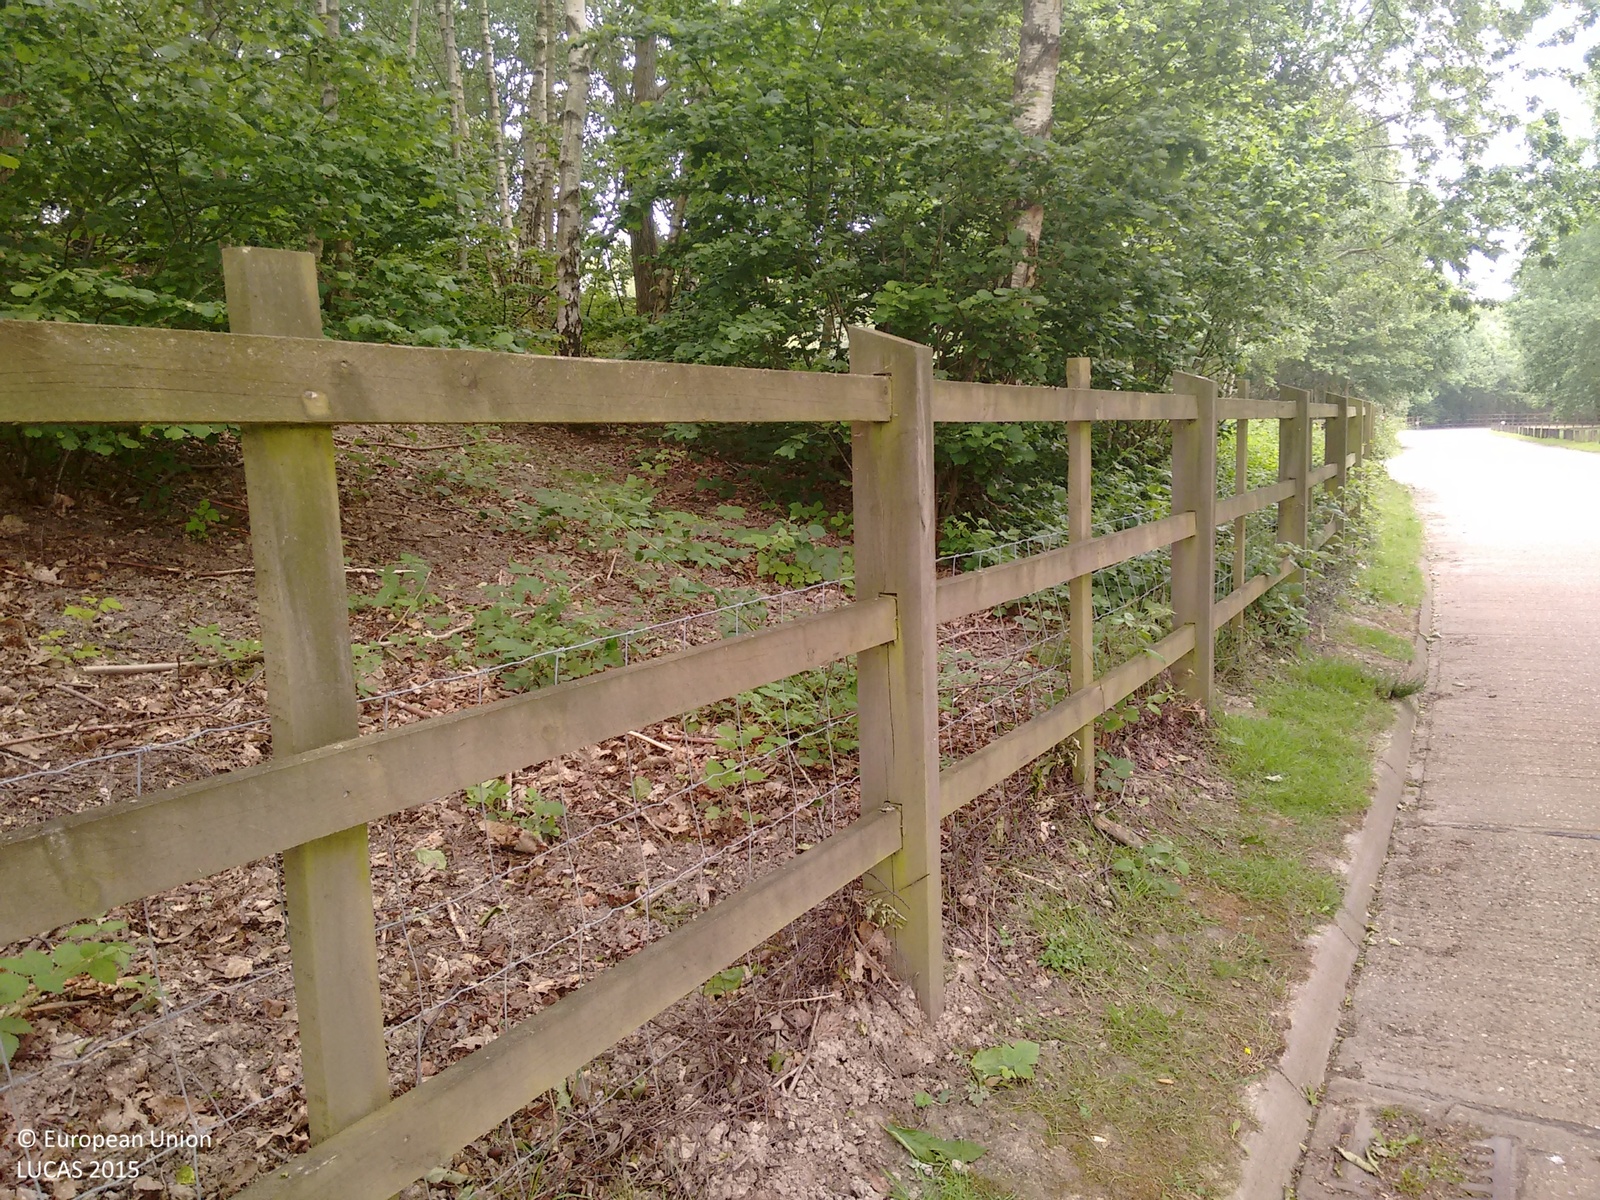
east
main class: Woodland
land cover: Broadleaved woodland
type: mesophytic deciduous forest
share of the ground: > 75 %
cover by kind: broadleaved forest trees 90 %, shrubs 10 %
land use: Waste treatment
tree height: > 5 m
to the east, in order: Broadleaved woodland; Grassland without tree/shrub cover; Paved roads, cycling and walking lanes; Grassland without tree/shrub cover; Broadleaved woodland; Grassland without tree/shrub cover; Broadleaved woodland; Fences; Broadleaved woodland; Grassland without tree/shrub cover; Fences; Grassland without tree/shrub cover
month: June
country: GB
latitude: 51.0816
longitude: 0.3927
